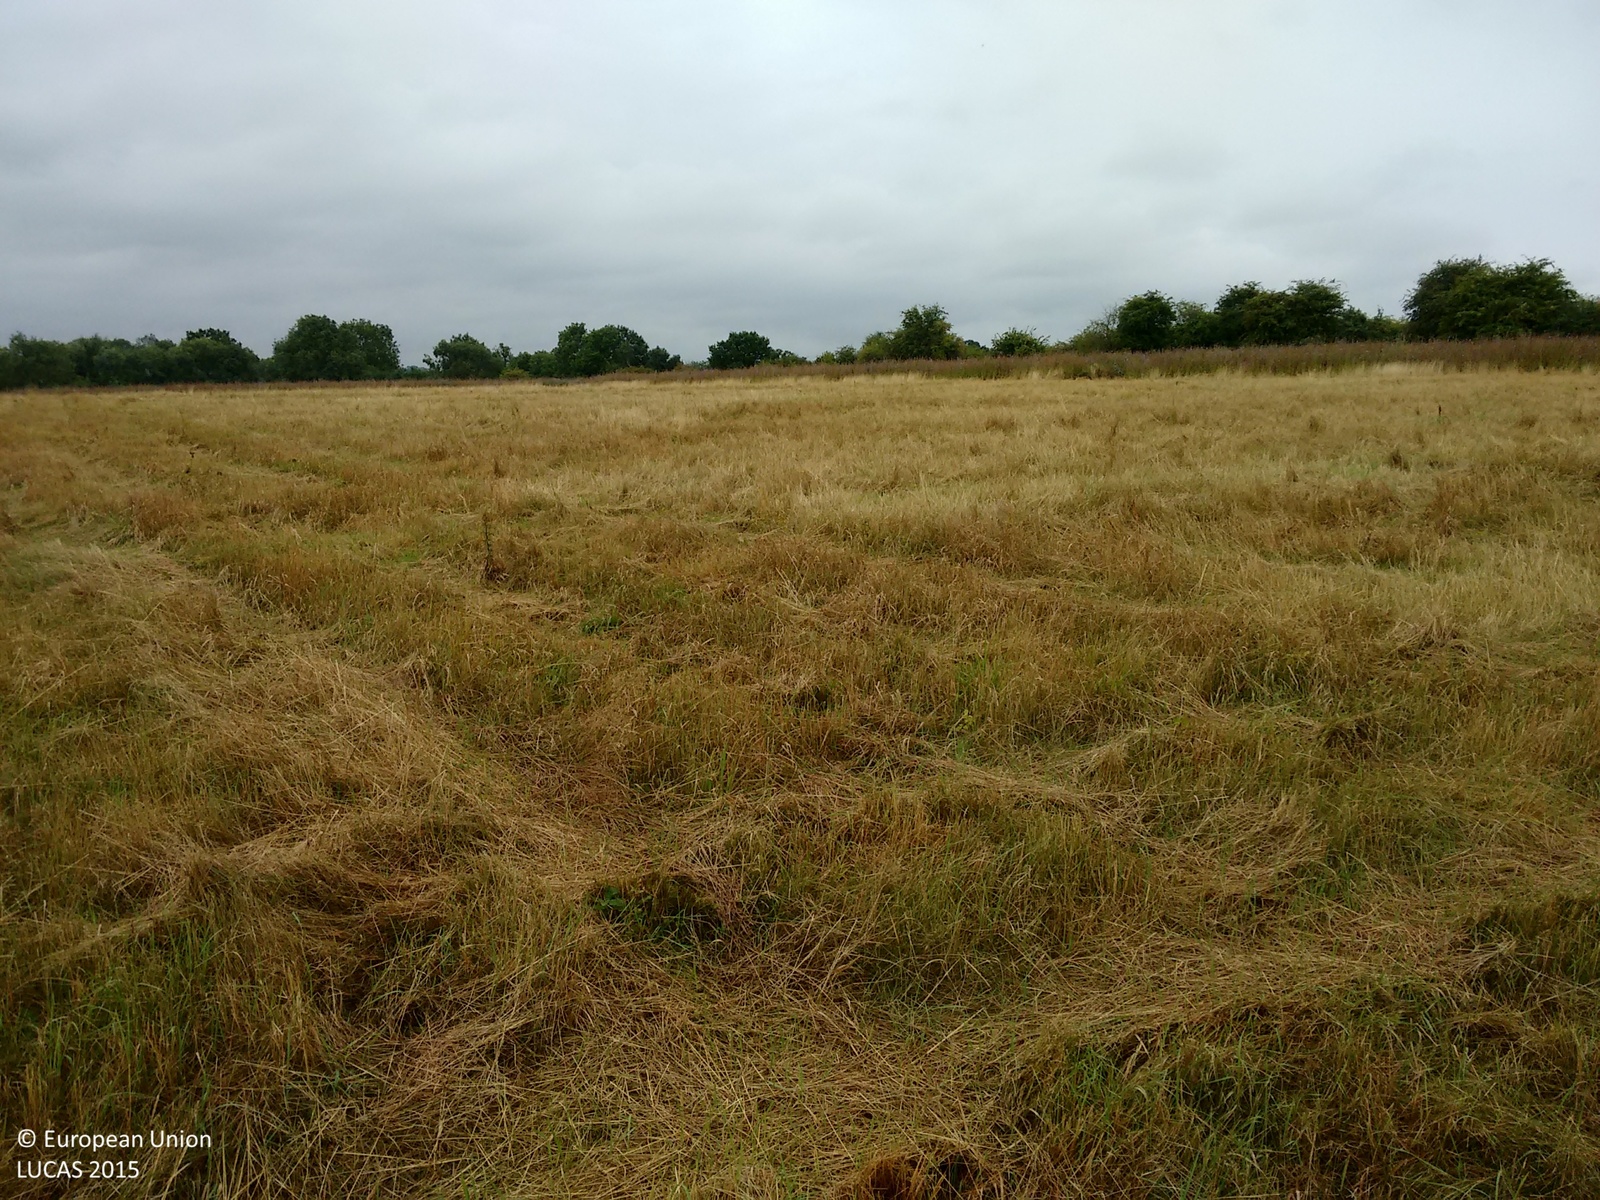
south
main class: Grassland
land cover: Grassland without tree/shrub cover
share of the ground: > 75 %
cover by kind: herbaceous plants 100 %
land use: Agriculture (excluding fallow land and kitchen gardens)
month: August
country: GB
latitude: 52.1543
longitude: -1.1991
